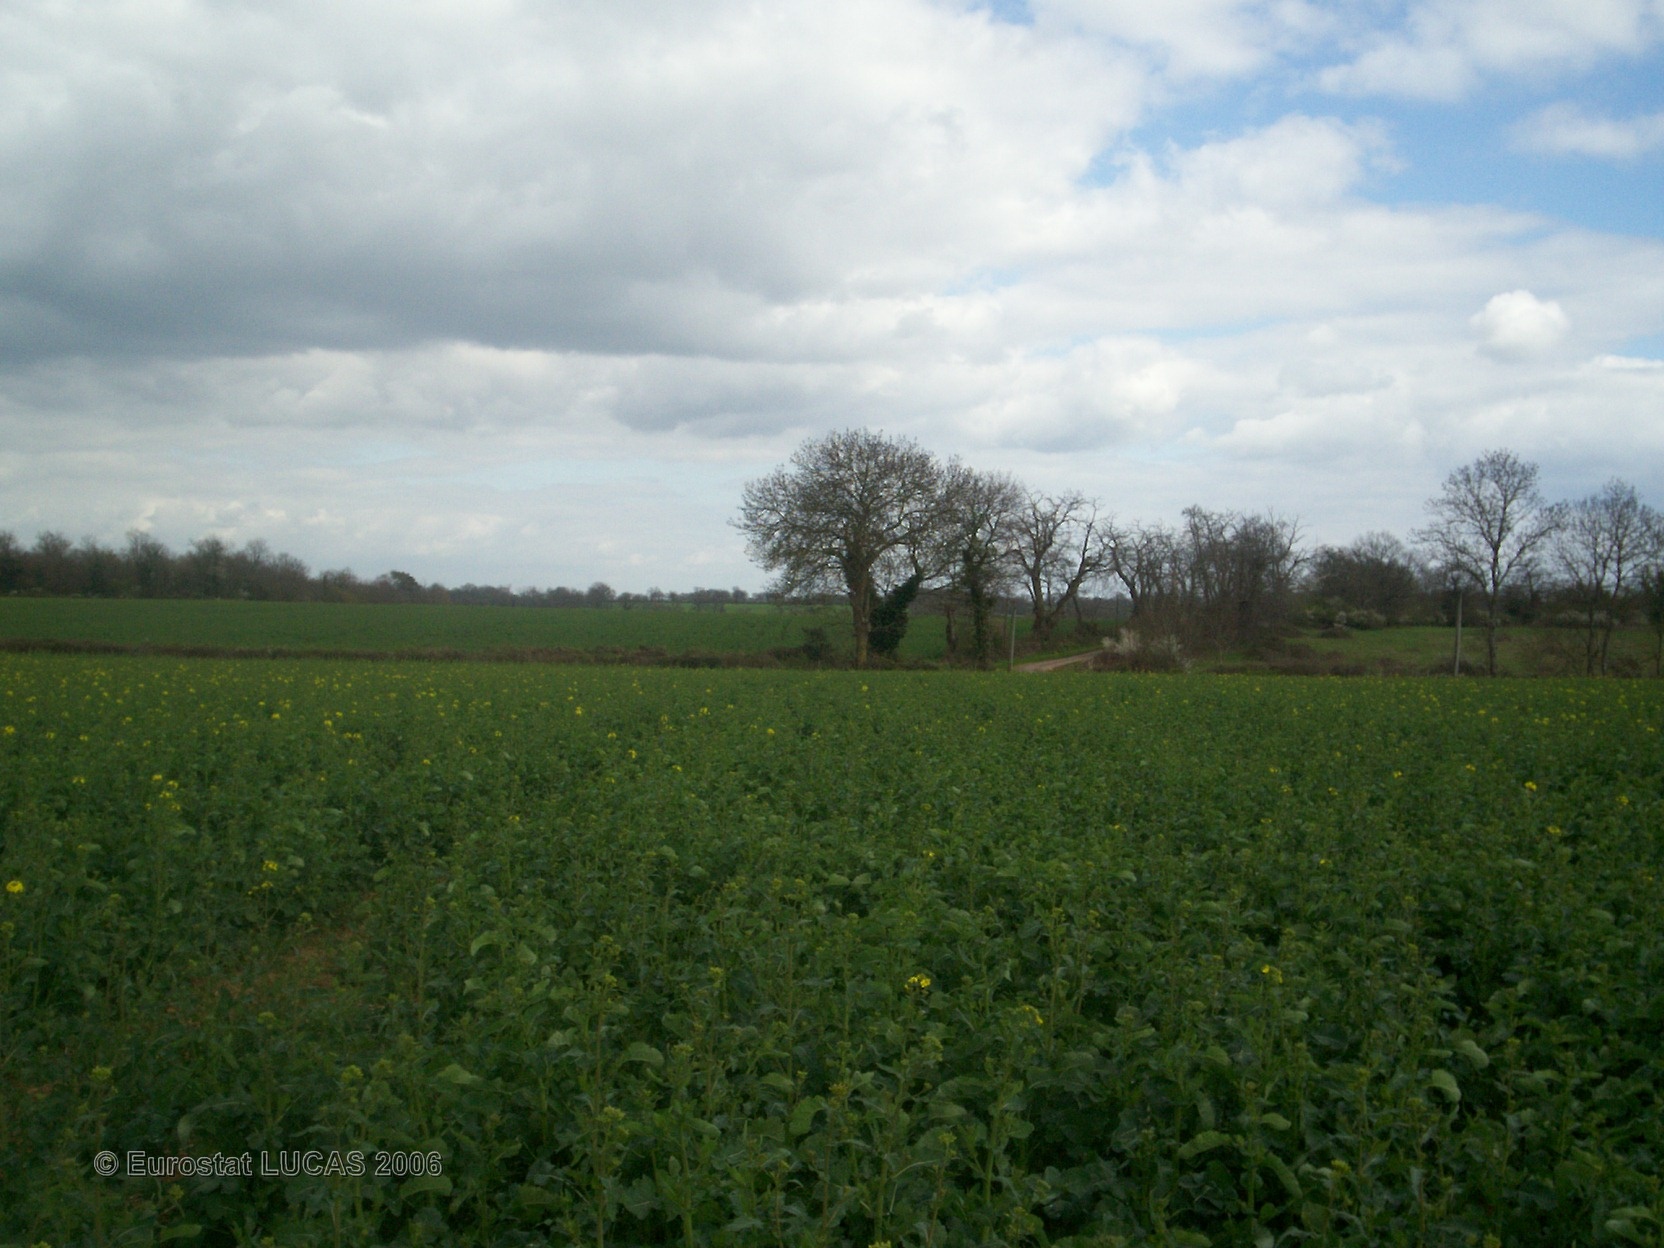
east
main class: Cropland
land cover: Rape and turnip rape
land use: Agriculture (excluding fallow land and kitchen gardens)
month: April
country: FR
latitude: 46.4124
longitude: 1.0758
